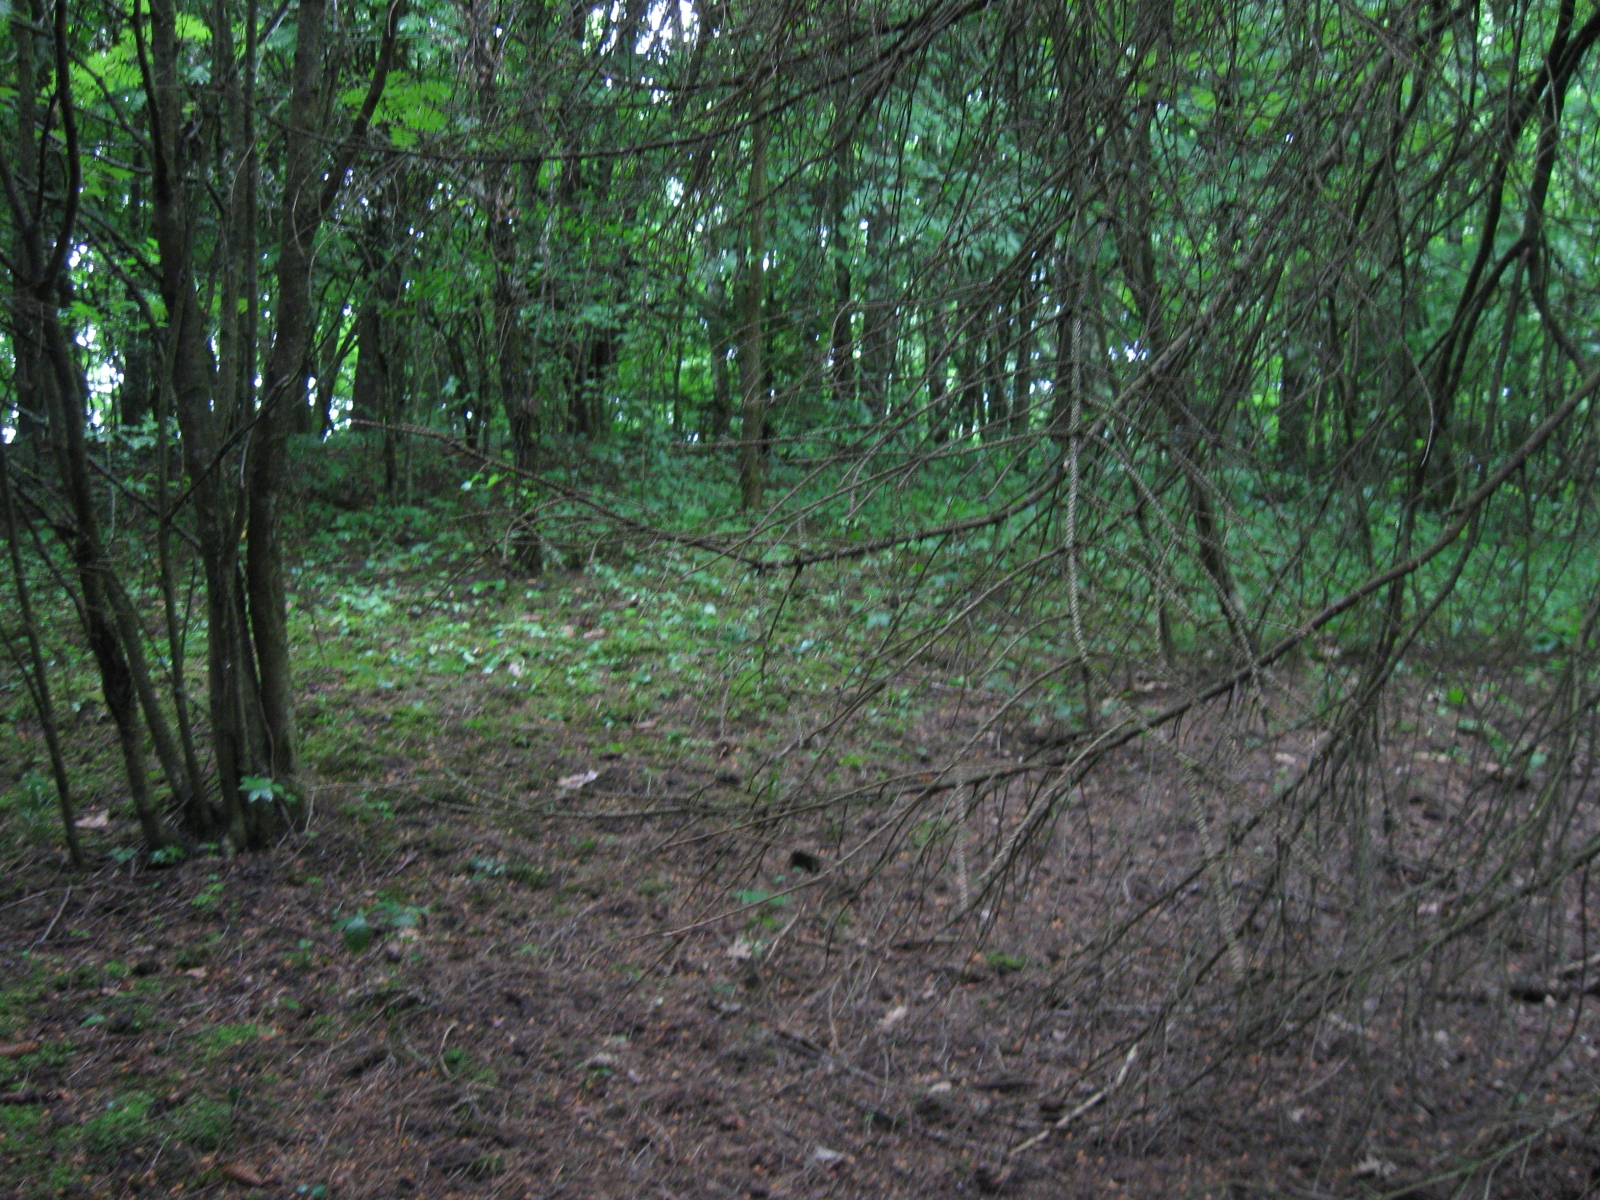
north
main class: Woodland
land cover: Spruce dominated coniferous woodland
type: hemiboreal forest and nemoral coniferous forest and mixed broadleaved-coniferous forest
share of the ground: > 75 %
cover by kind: coniferous forest trees 85 %, broadleaved forest trees 15 %
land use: Forestry
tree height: > 5 m
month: June
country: LT
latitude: 54.6025
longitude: 24.3885
